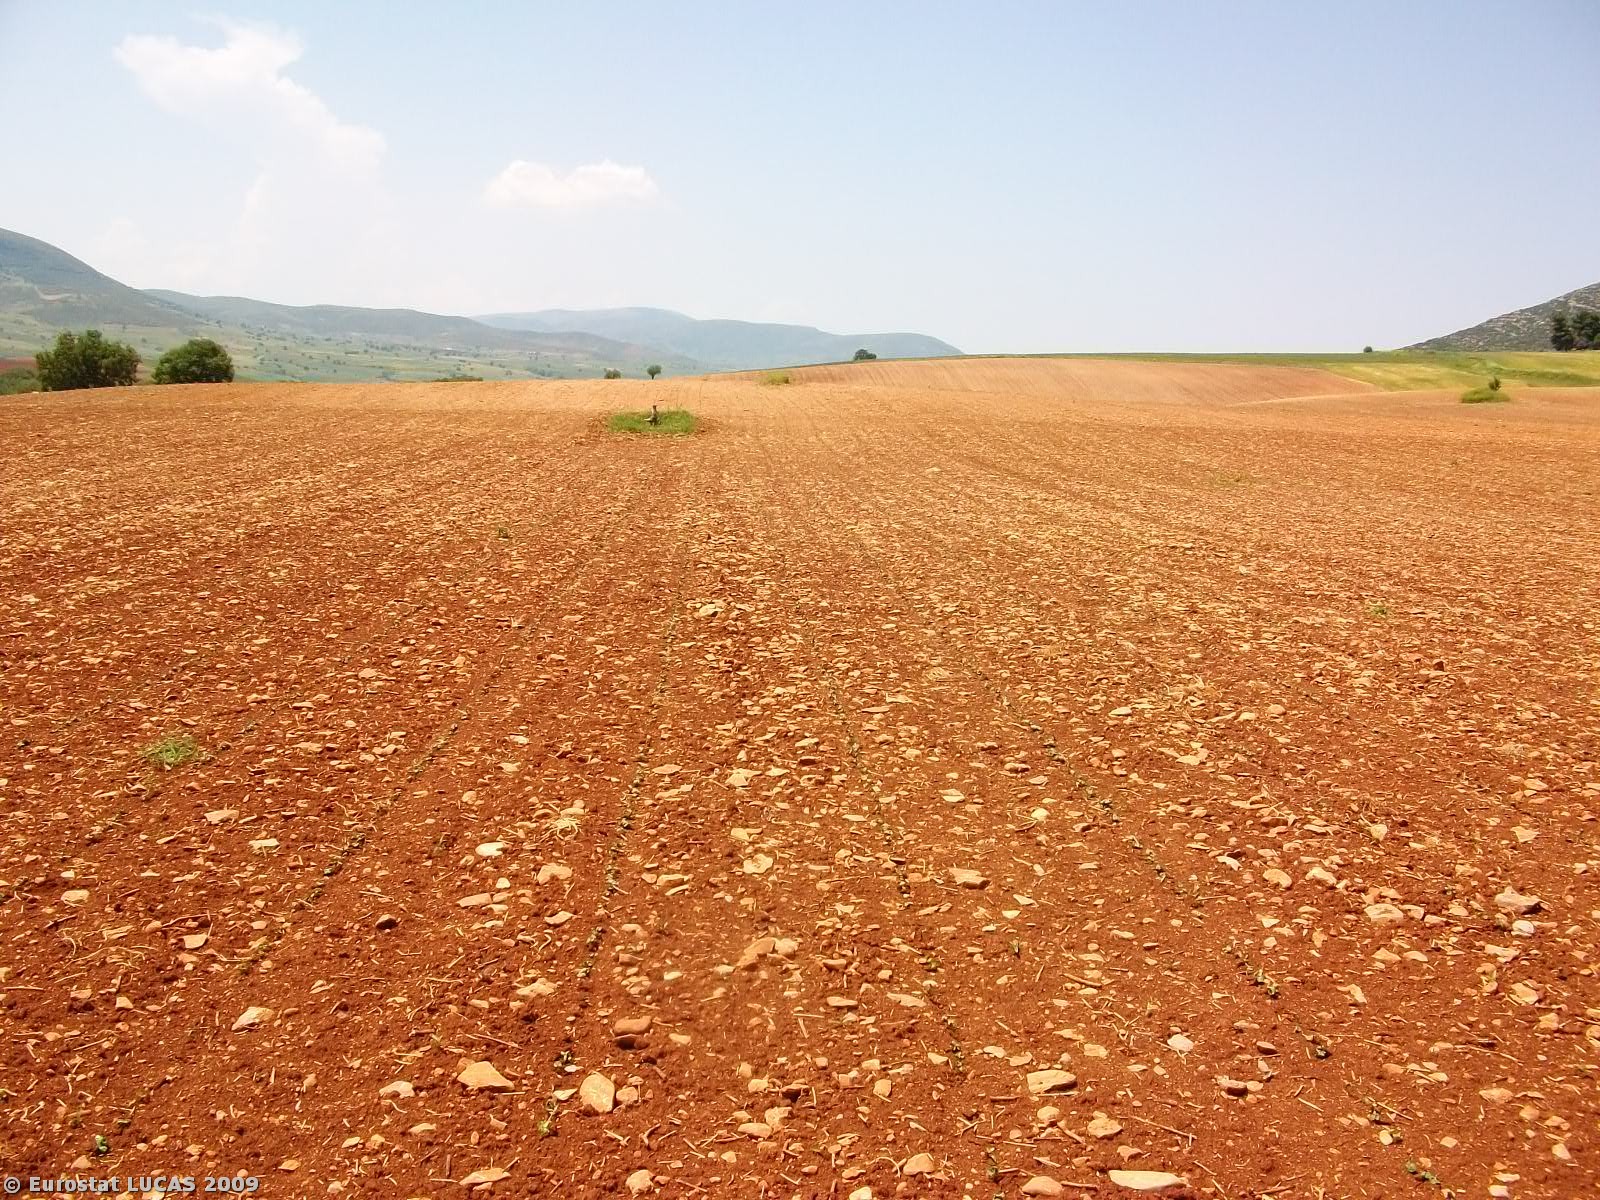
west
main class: Cropland
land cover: Cotton
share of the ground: < 10 %
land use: Agriculture (excluding fallow land and kitchen gardens)
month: May
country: GR
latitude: 39.2168
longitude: 22.5758
